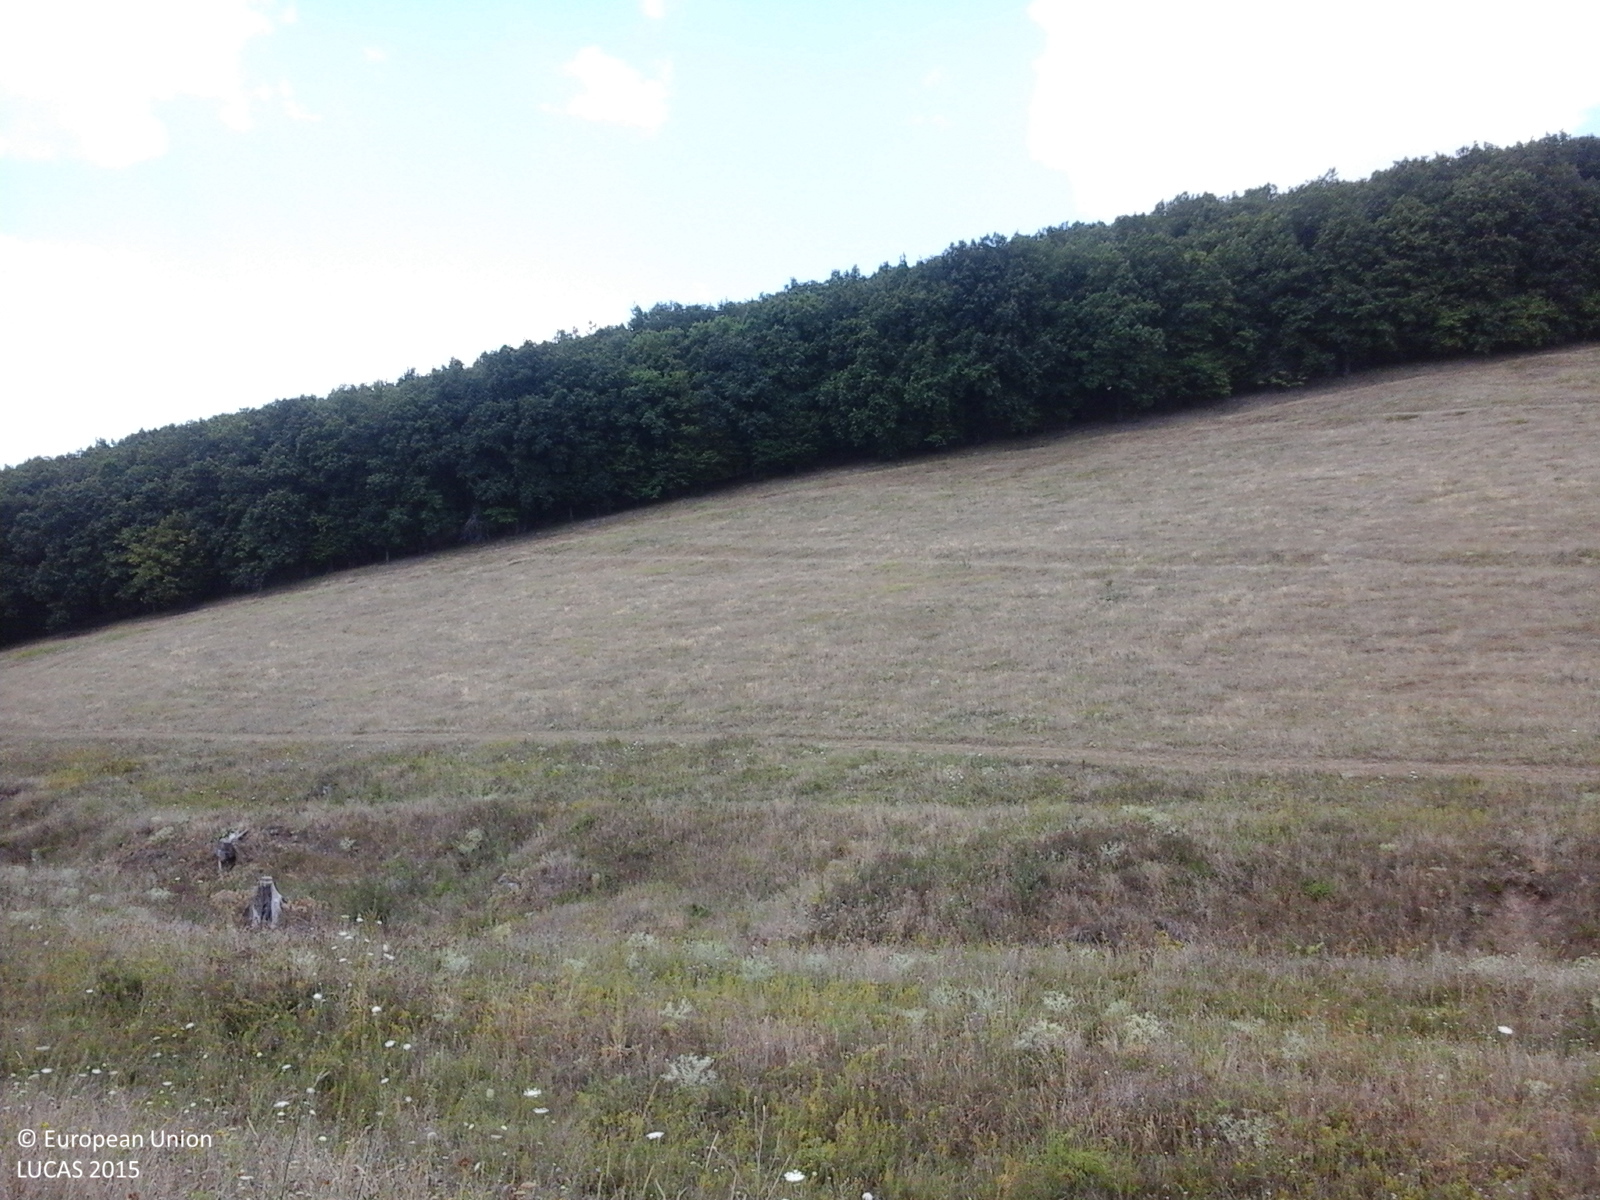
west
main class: Grassland
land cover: Grassland without tree/shrub cover
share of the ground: > 75 %
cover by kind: herbaceous plants 100 %
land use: Agriculture (excluding fallow land and kitchen gardens)
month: July
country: RO
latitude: 46.6027
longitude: 27.2986
